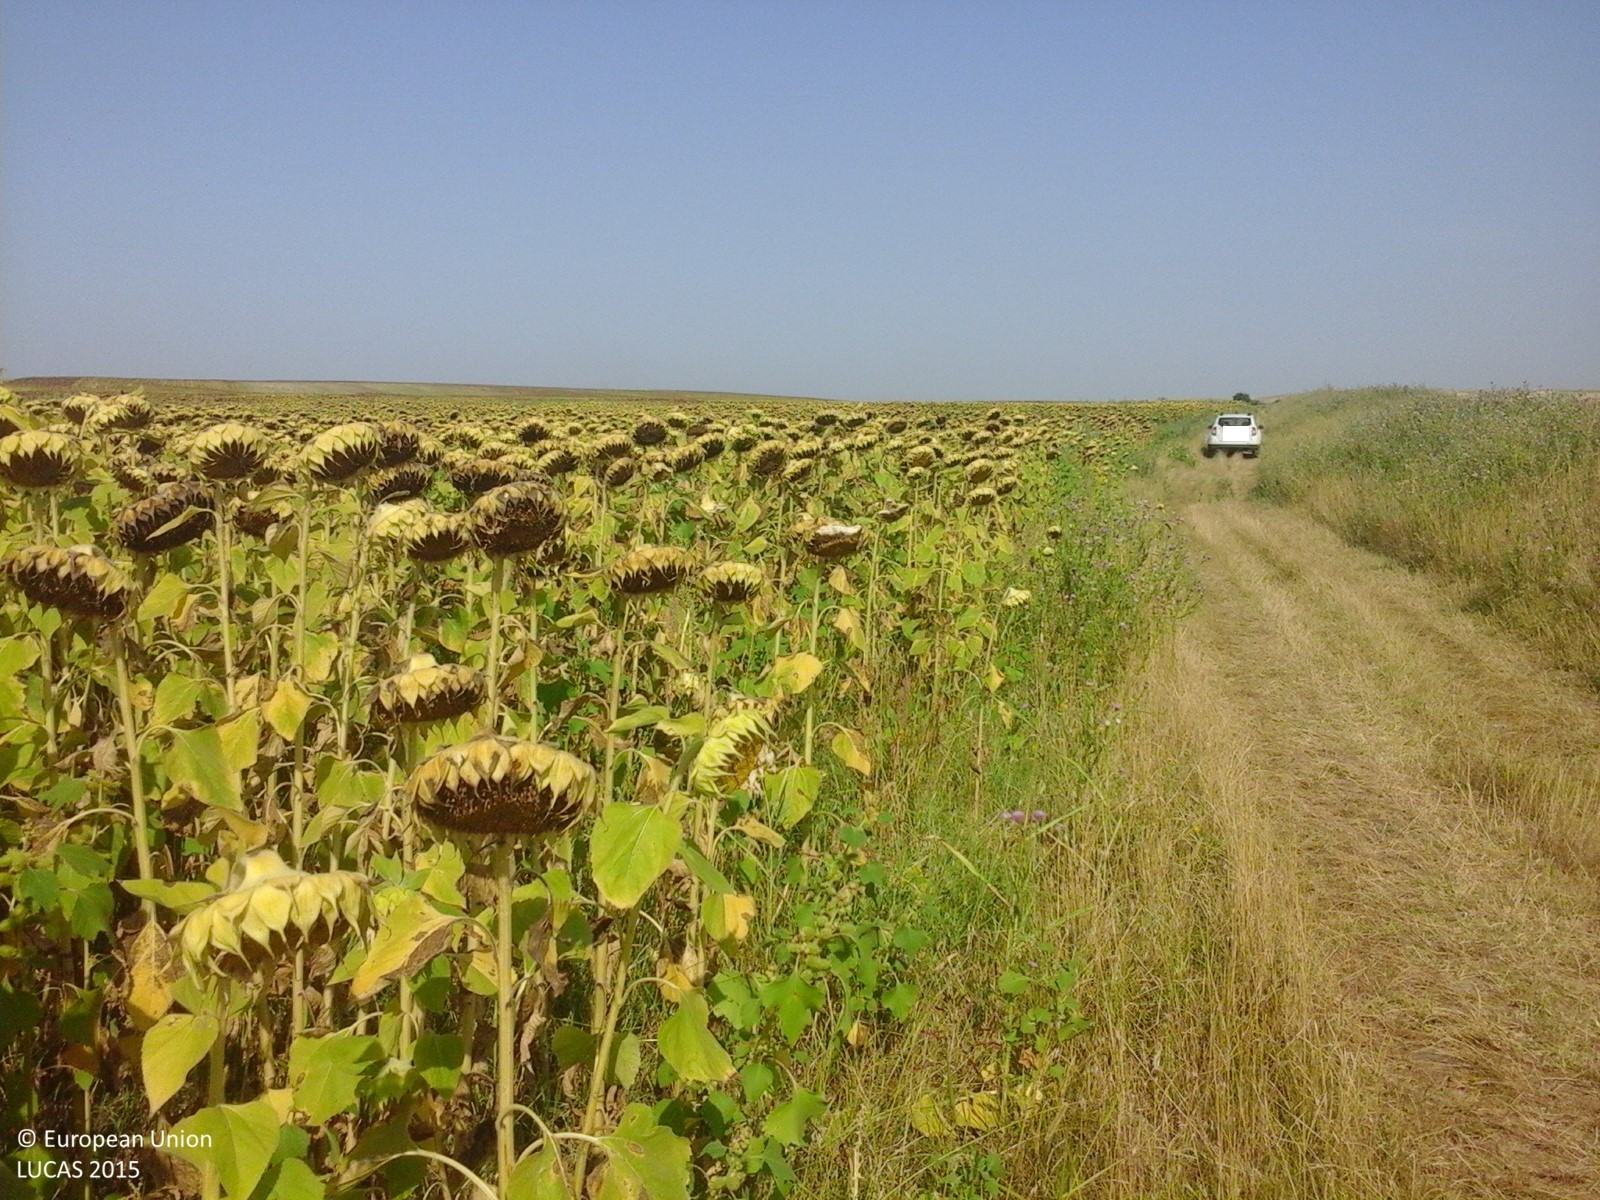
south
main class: Cropland
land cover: Sunflower
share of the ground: > 75 %
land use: Agriculture (excluding fallow land and kitchen gardens)
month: August
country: RO
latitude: 44.1314
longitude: 23.2827
